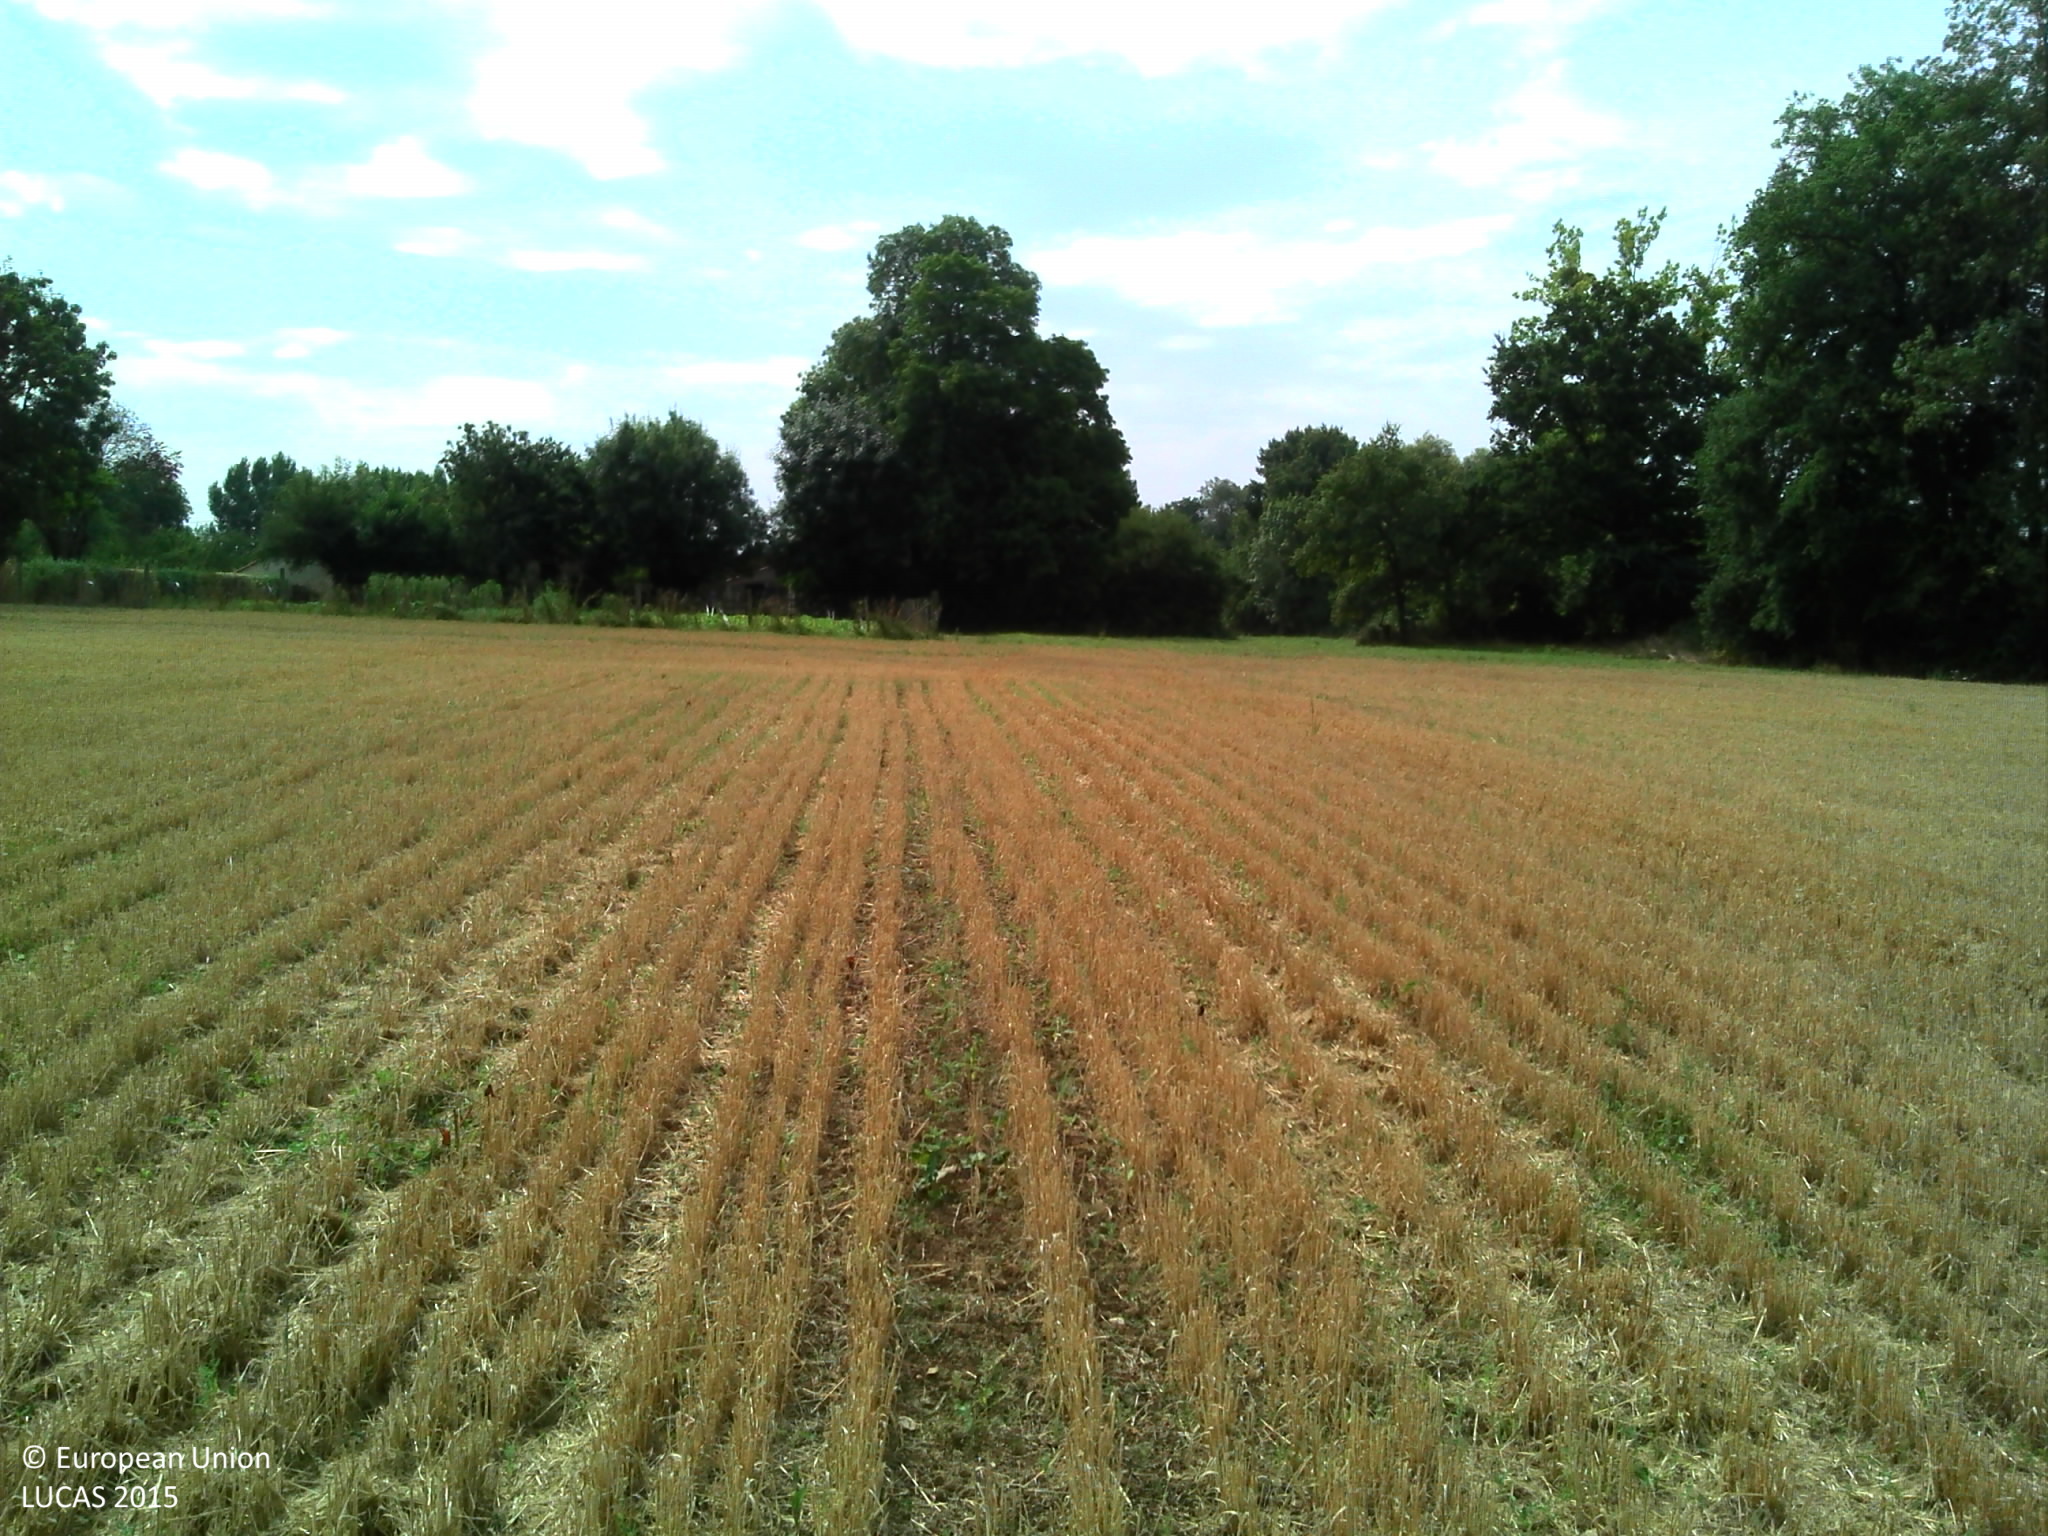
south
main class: Cropland
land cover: Barley
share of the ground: > 75 %
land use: Agriculture (excluding fallow land and kitchen gardens)
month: August
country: FR
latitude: 46.9515
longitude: -1.4576
